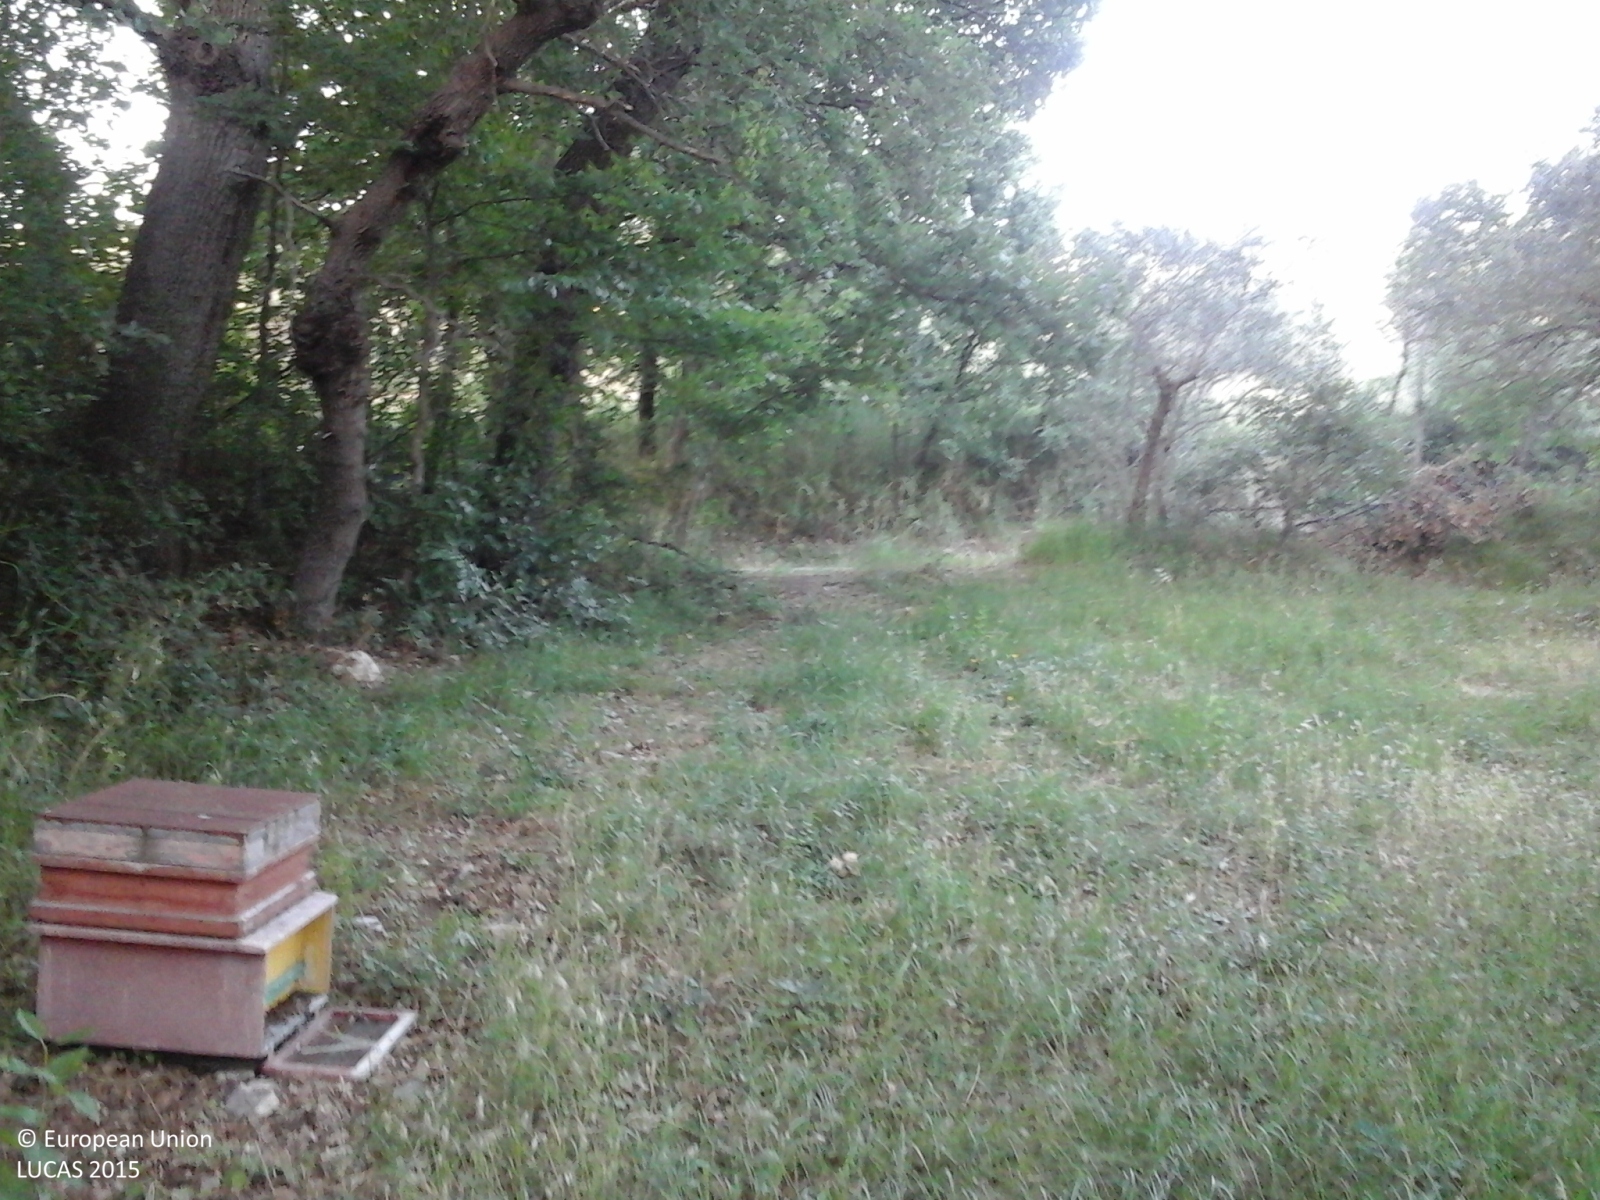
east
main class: Woodland
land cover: Broadleaved woodland
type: thermophilous deciduous forest
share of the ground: > 75 %
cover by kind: broadleaved forest trees 80 %, shrubs 10 %, herbaceous plants 10 %
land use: Semi-natural and natural areas not in use
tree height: > 5 m
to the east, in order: Broadleaved woodland; Paved roads, cycling and walking lanes; Grass margins; Electric lines; Ditches and canals; Olive groves; Grassland without tree/shrub cover; Durum wheat; Electric lines; Durum wheat; Grassland without tree/shrub cover; Durum wheat; Grass margins; Tracks; Grass margins; Durum wheat
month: June
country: IT
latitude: 42.0743
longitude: 14.3013
